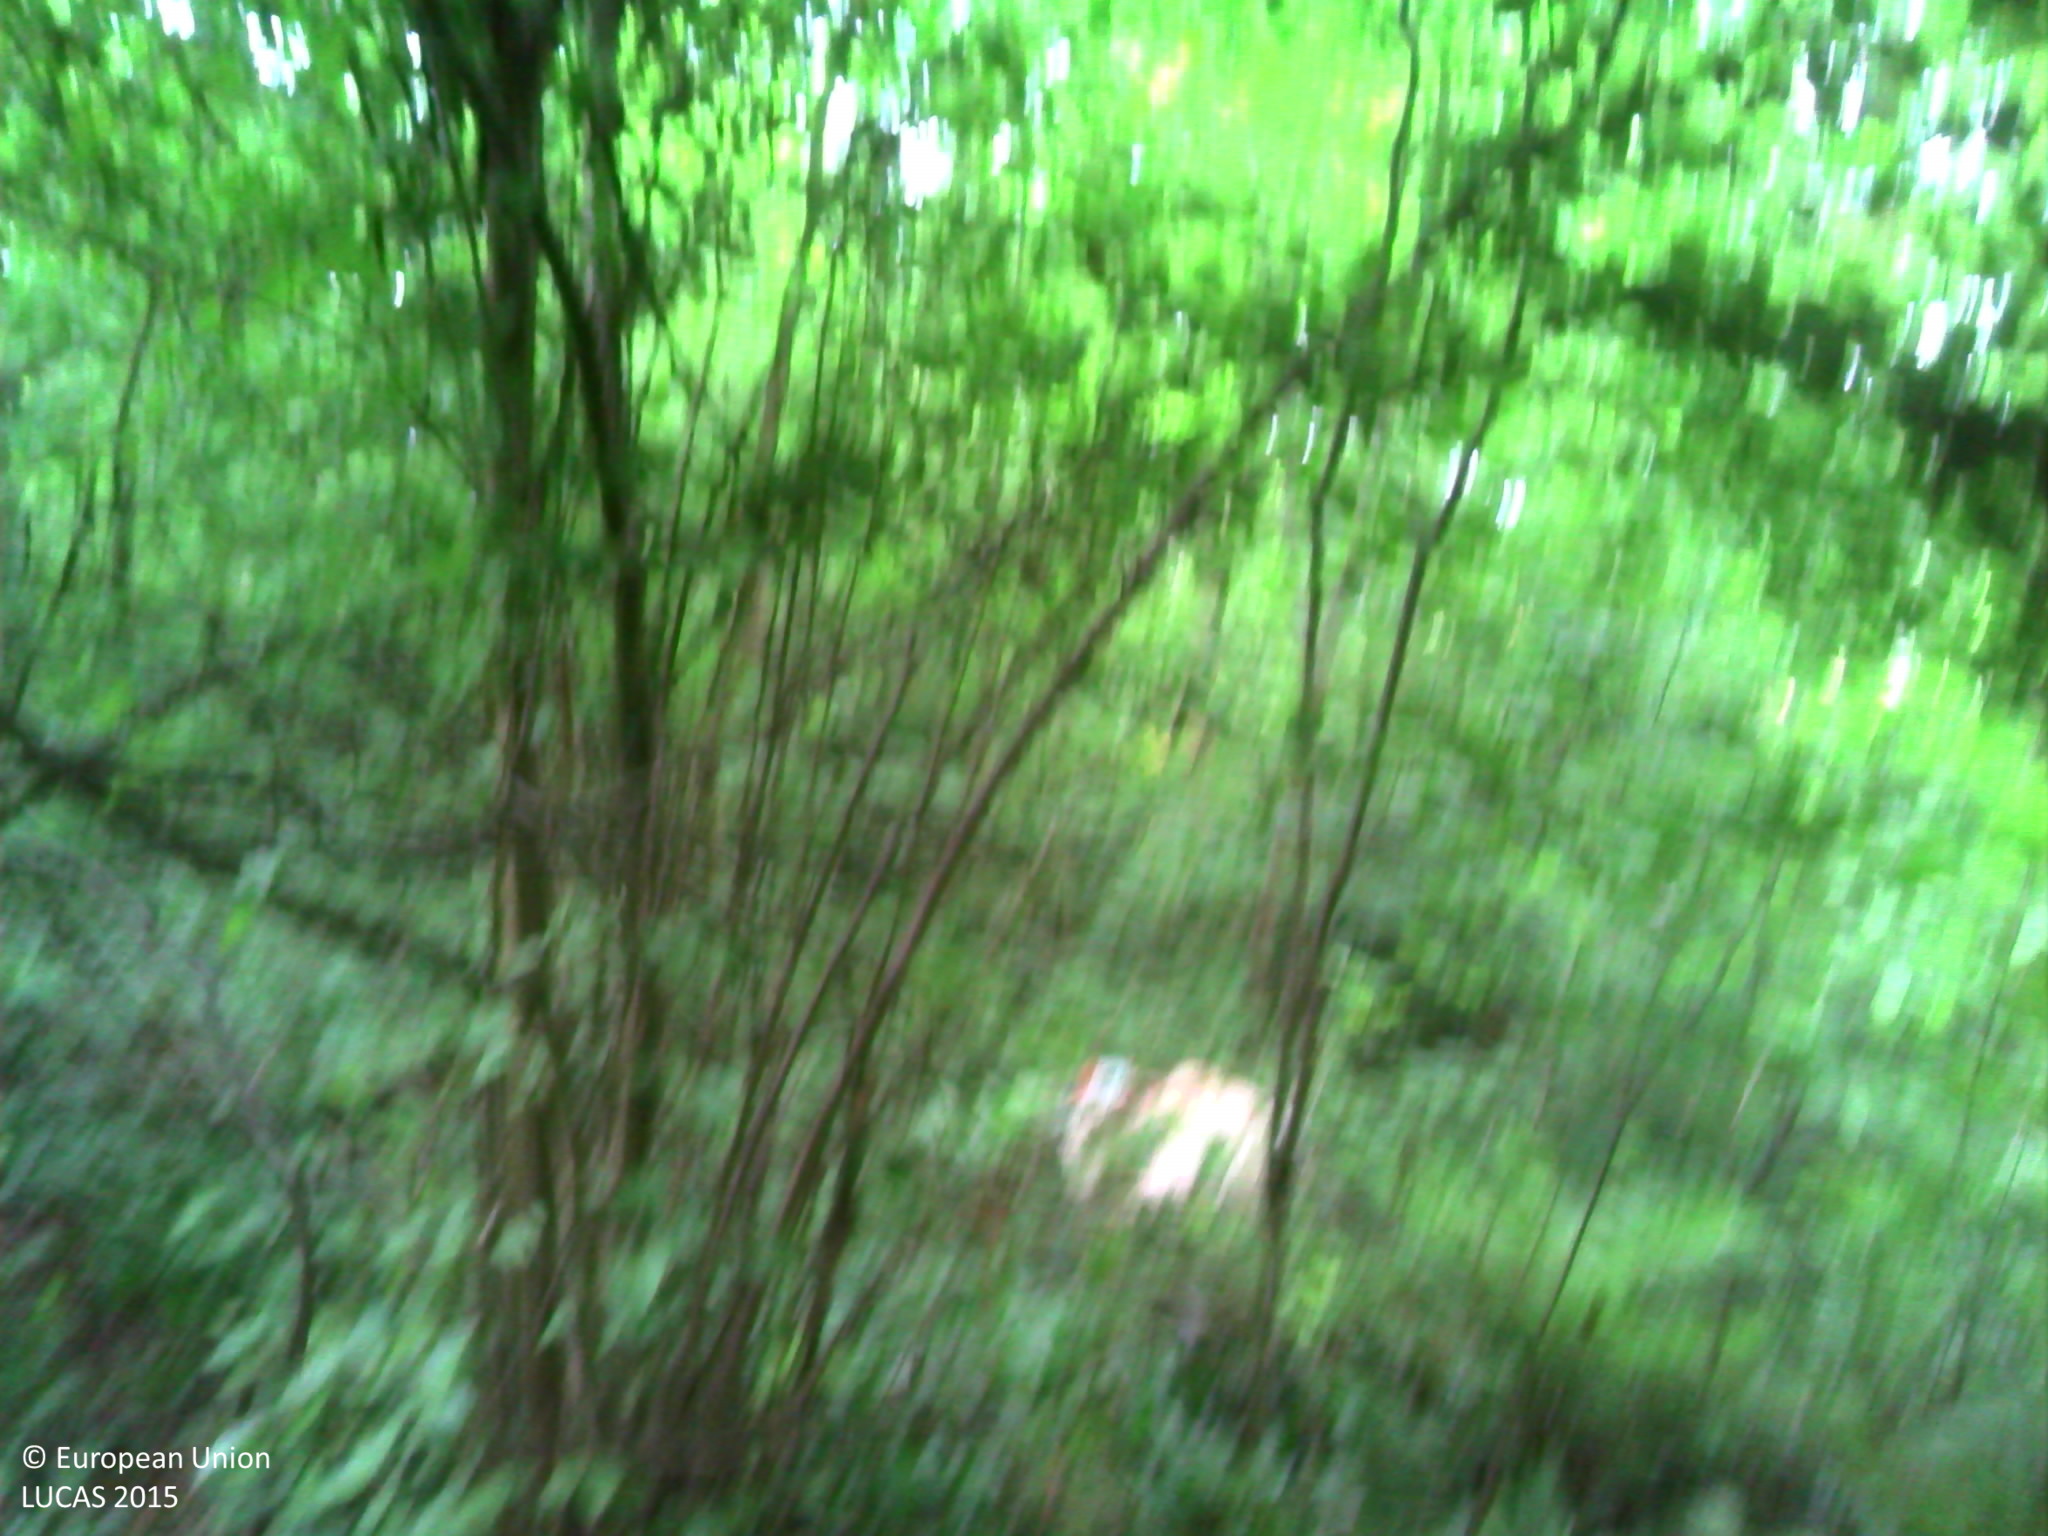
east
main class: Woodland
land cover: Broadleaved woodland
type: mesophytic deciduous forest
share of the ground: > 75 %
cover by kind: broadleaved forest trees 100 %
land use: Forestry
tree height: > 5 m
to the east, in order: Broadleaved woodland; Artificial constructions in urban areas; Broadleaved woodland
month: May
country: BE
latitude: 50.7038
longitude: 4.5729
